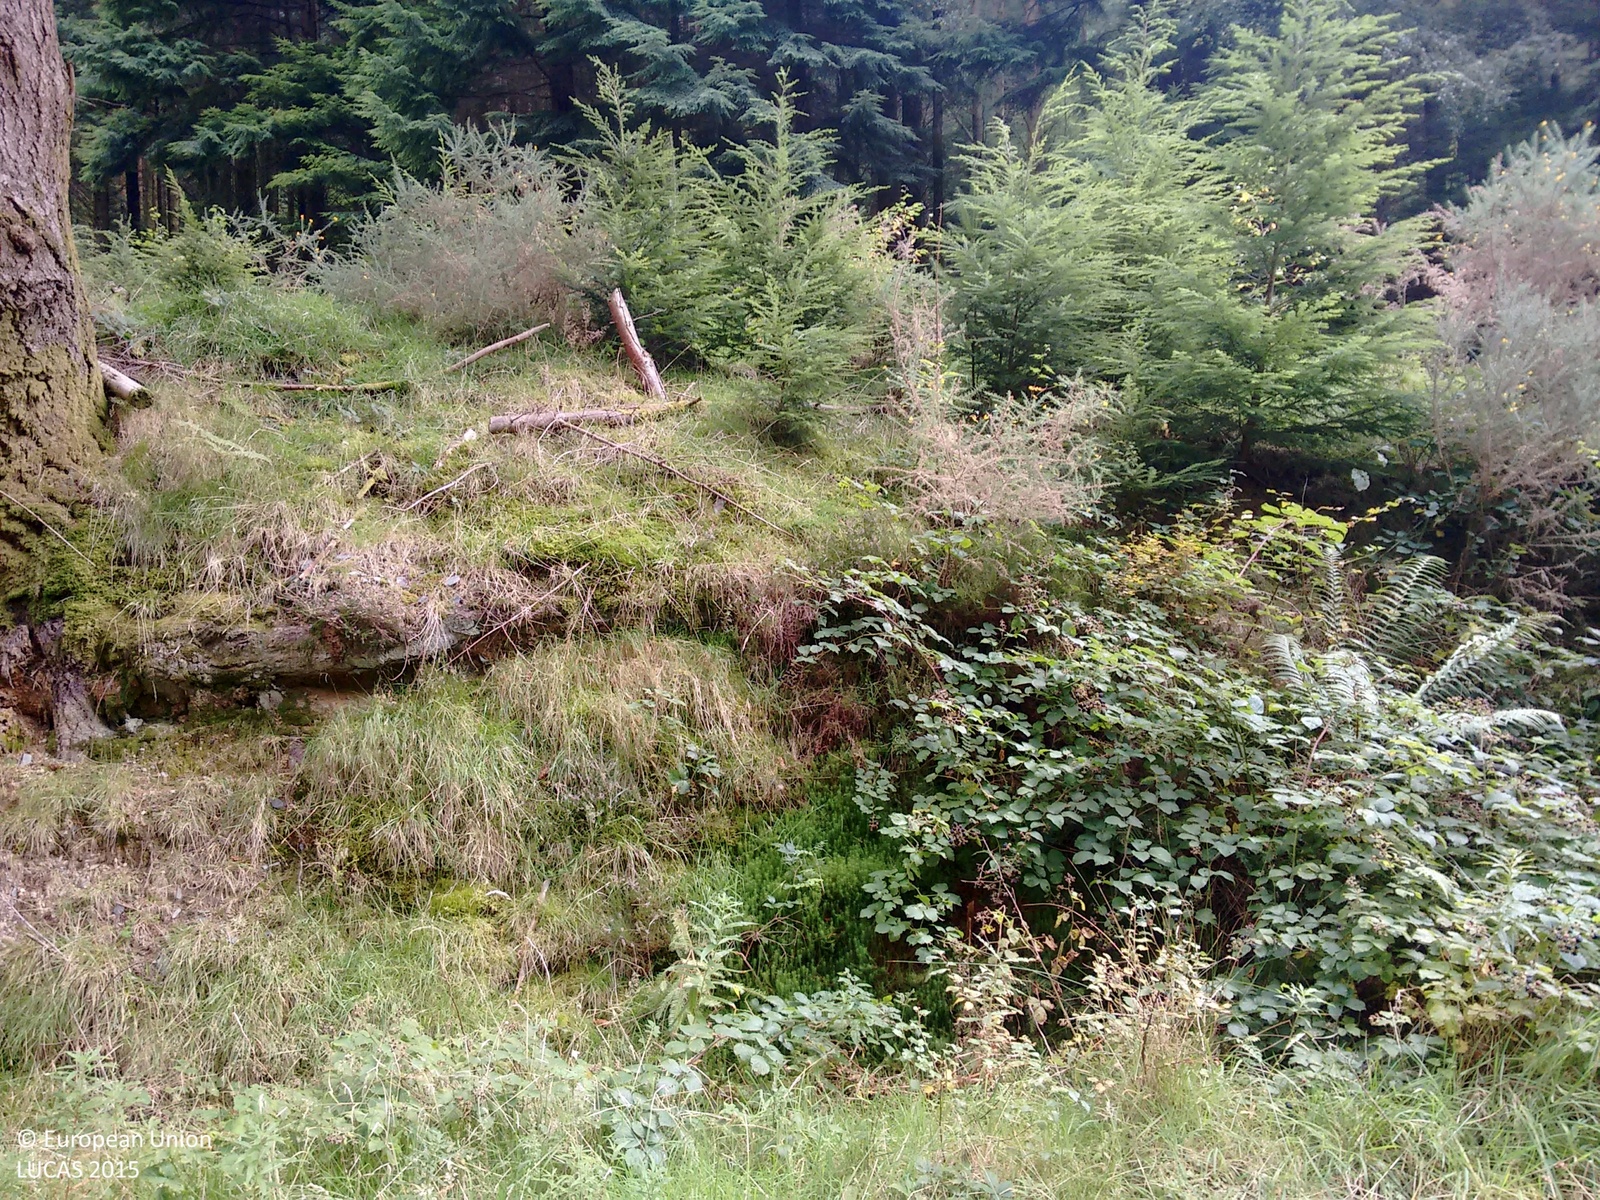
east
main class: Woodland
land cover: Other coniferous woodland
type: exotic forest
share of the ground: > 75 %
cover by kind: coniferous forest trees 100 %
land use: Forestry
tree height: > 5 m
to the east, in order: Other coniferous woodland; Tracks; Other coniferous woodland; Pine dominated coniferous woodland; Tracks; Pine dominated coniferous woodland; Tracks; Pine dominated coniferous woodland
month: September
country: GB
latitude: 52.6897
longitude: -3.7144
